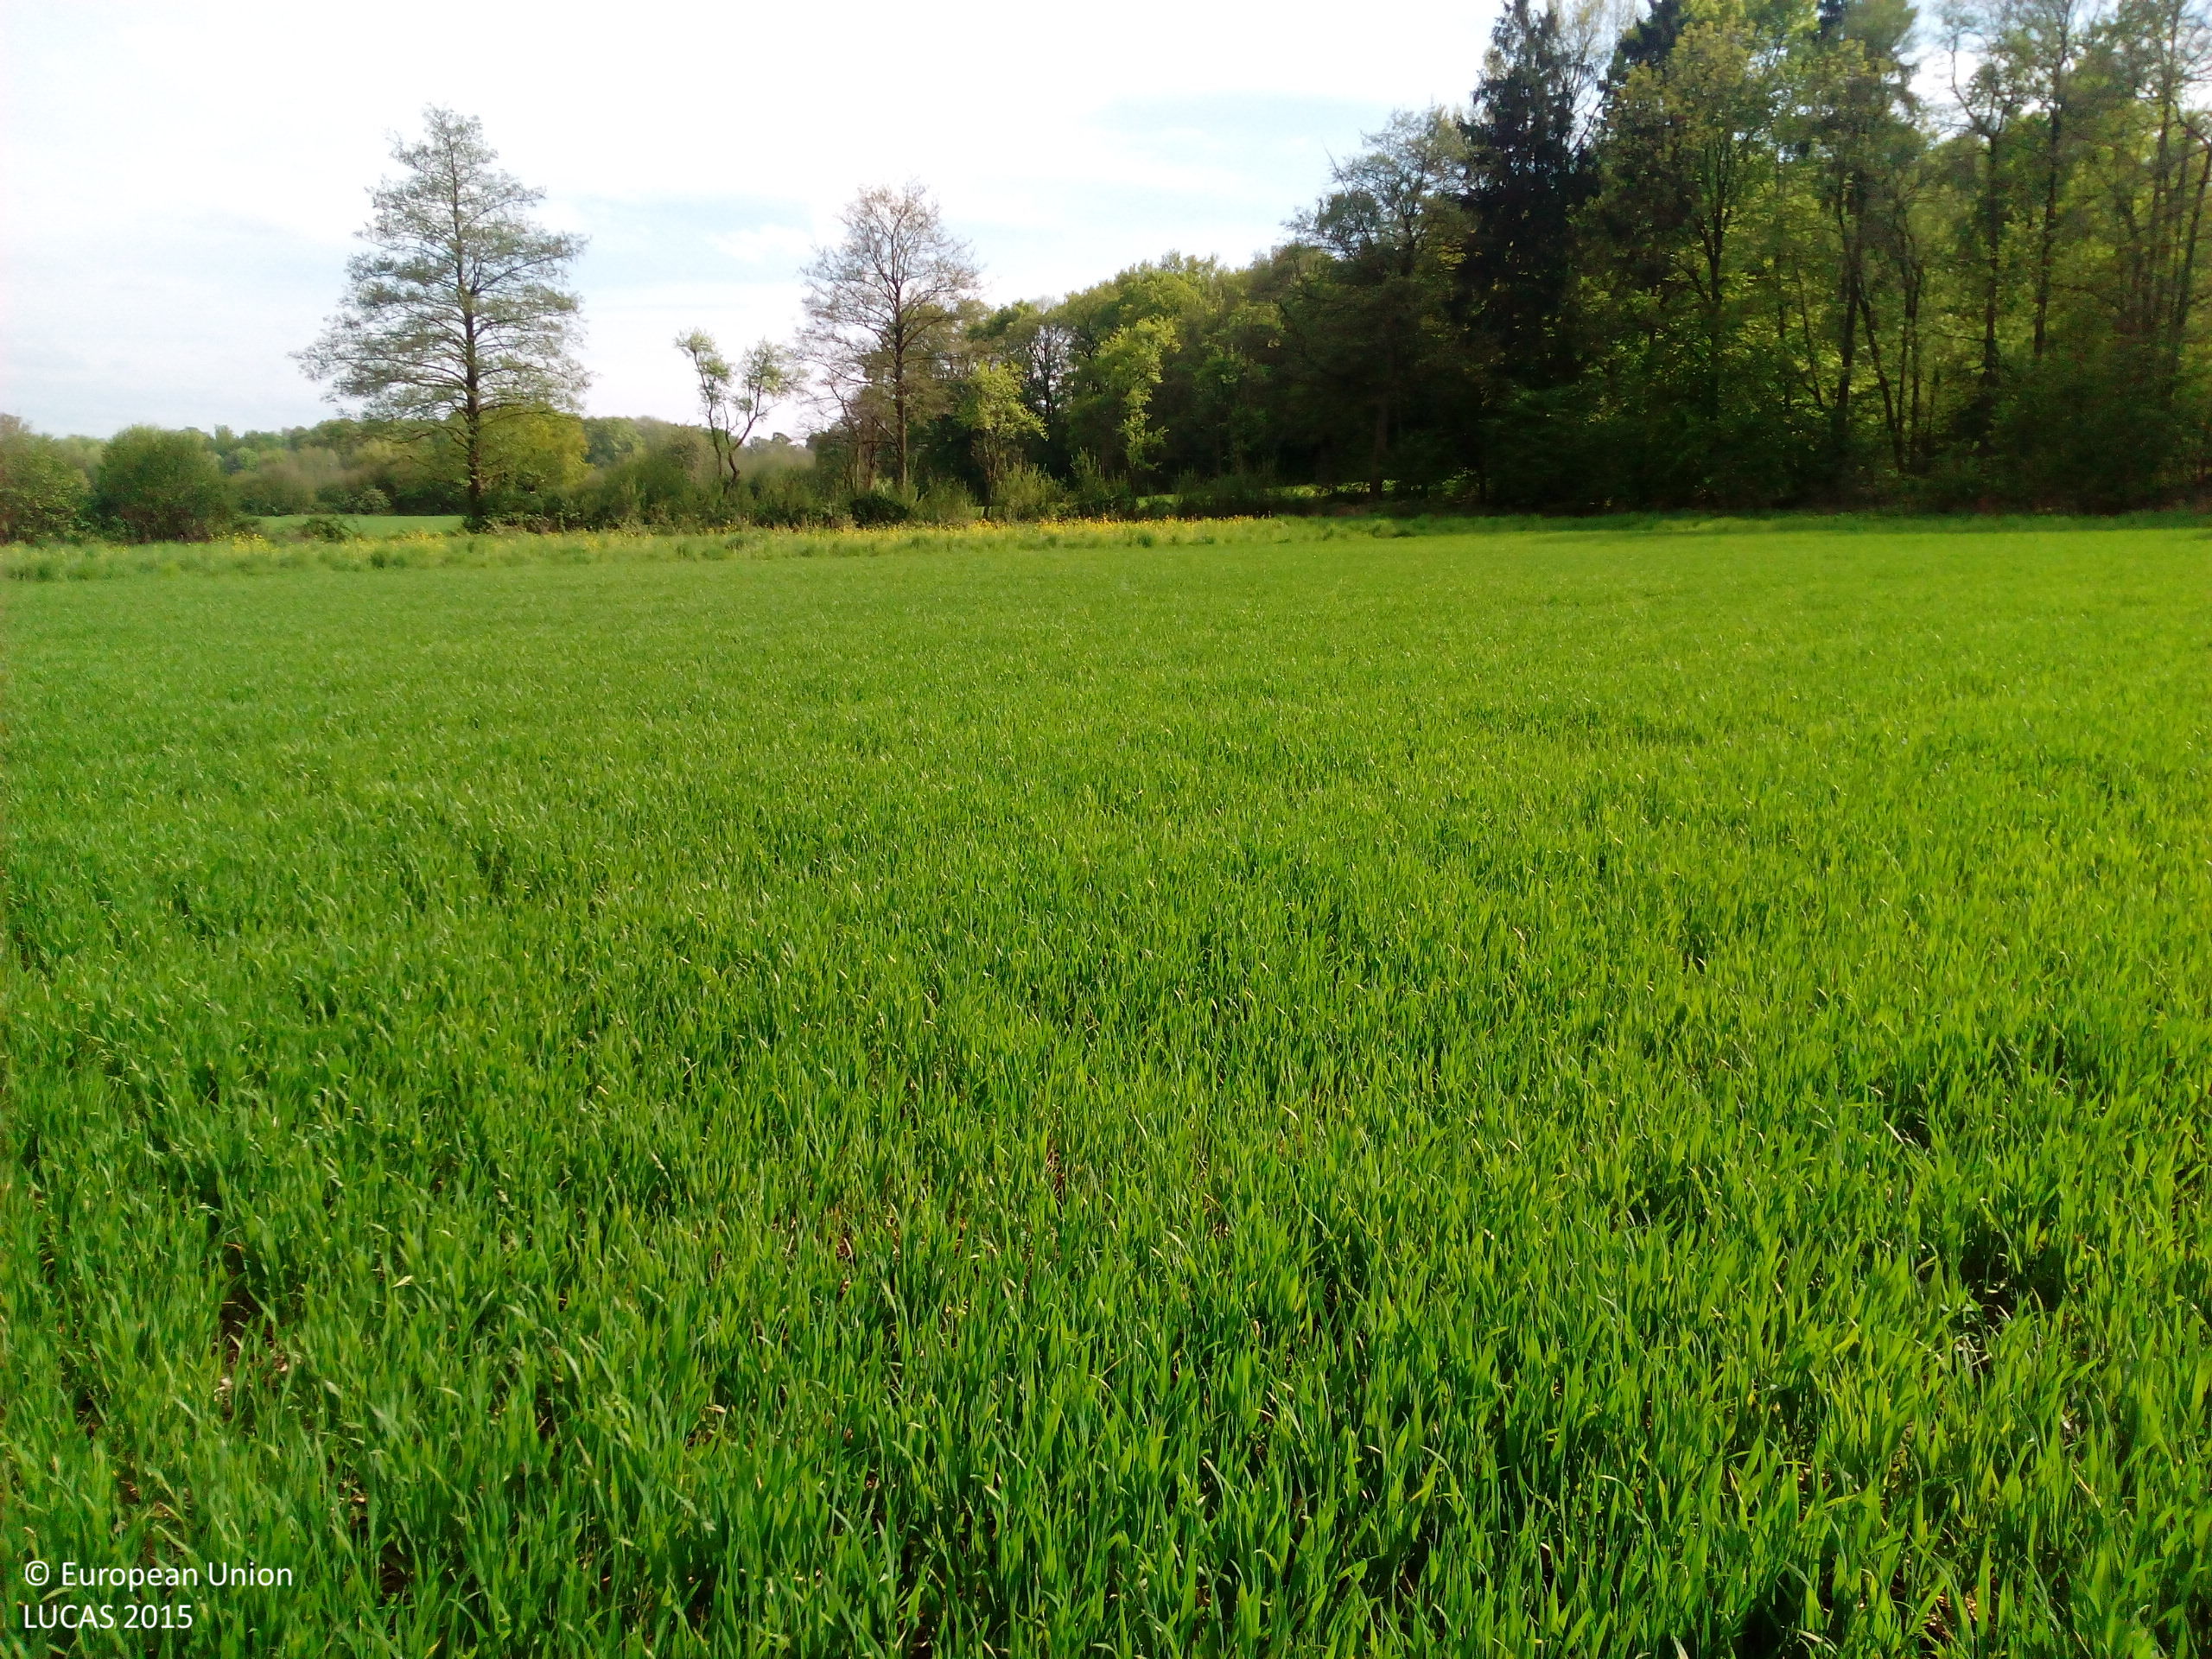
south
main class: Cropland
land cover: Common wheat
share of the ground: 50 - 75 %
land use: Agriculture (excluding fallow land and kitchen gardens)
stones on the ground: < 10 %
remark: Tilled/Sowed
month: May
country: DE
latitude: 51.7557
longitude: 7.4071
